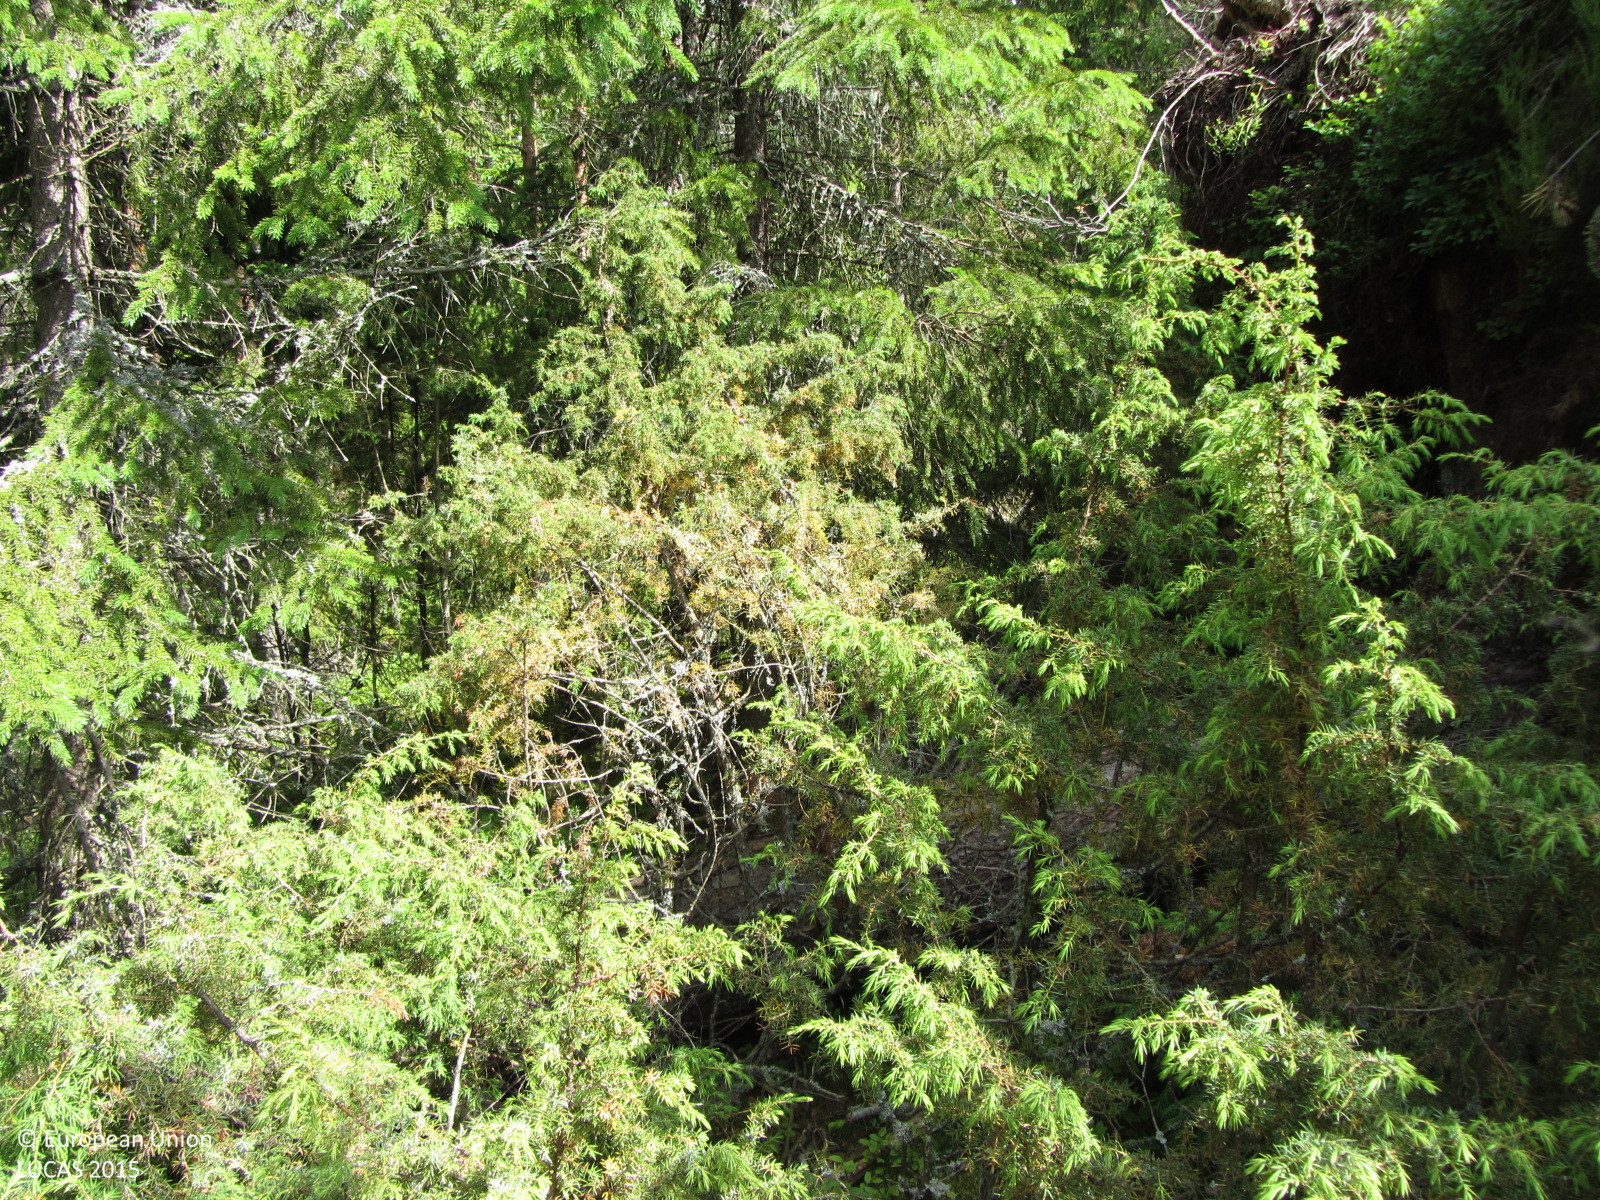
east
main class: Woodland
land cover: Pine dominated mixed woodland
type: boreal forest
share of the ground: 50 - 75 %
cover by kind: coniferous forest trees 45 %, shrubs 20 %, lichens and mosses 20 %, broadleaved forest trees 15 %
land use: Forestry
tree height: > 5 m
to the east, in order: Pine dominated mixed woodland; Other mixed woodland; Pine dominated coniferous woodland; Rock outcrops; Other coniferous woodland
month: June
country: FI
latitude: 60.1267
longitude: 23.1686
